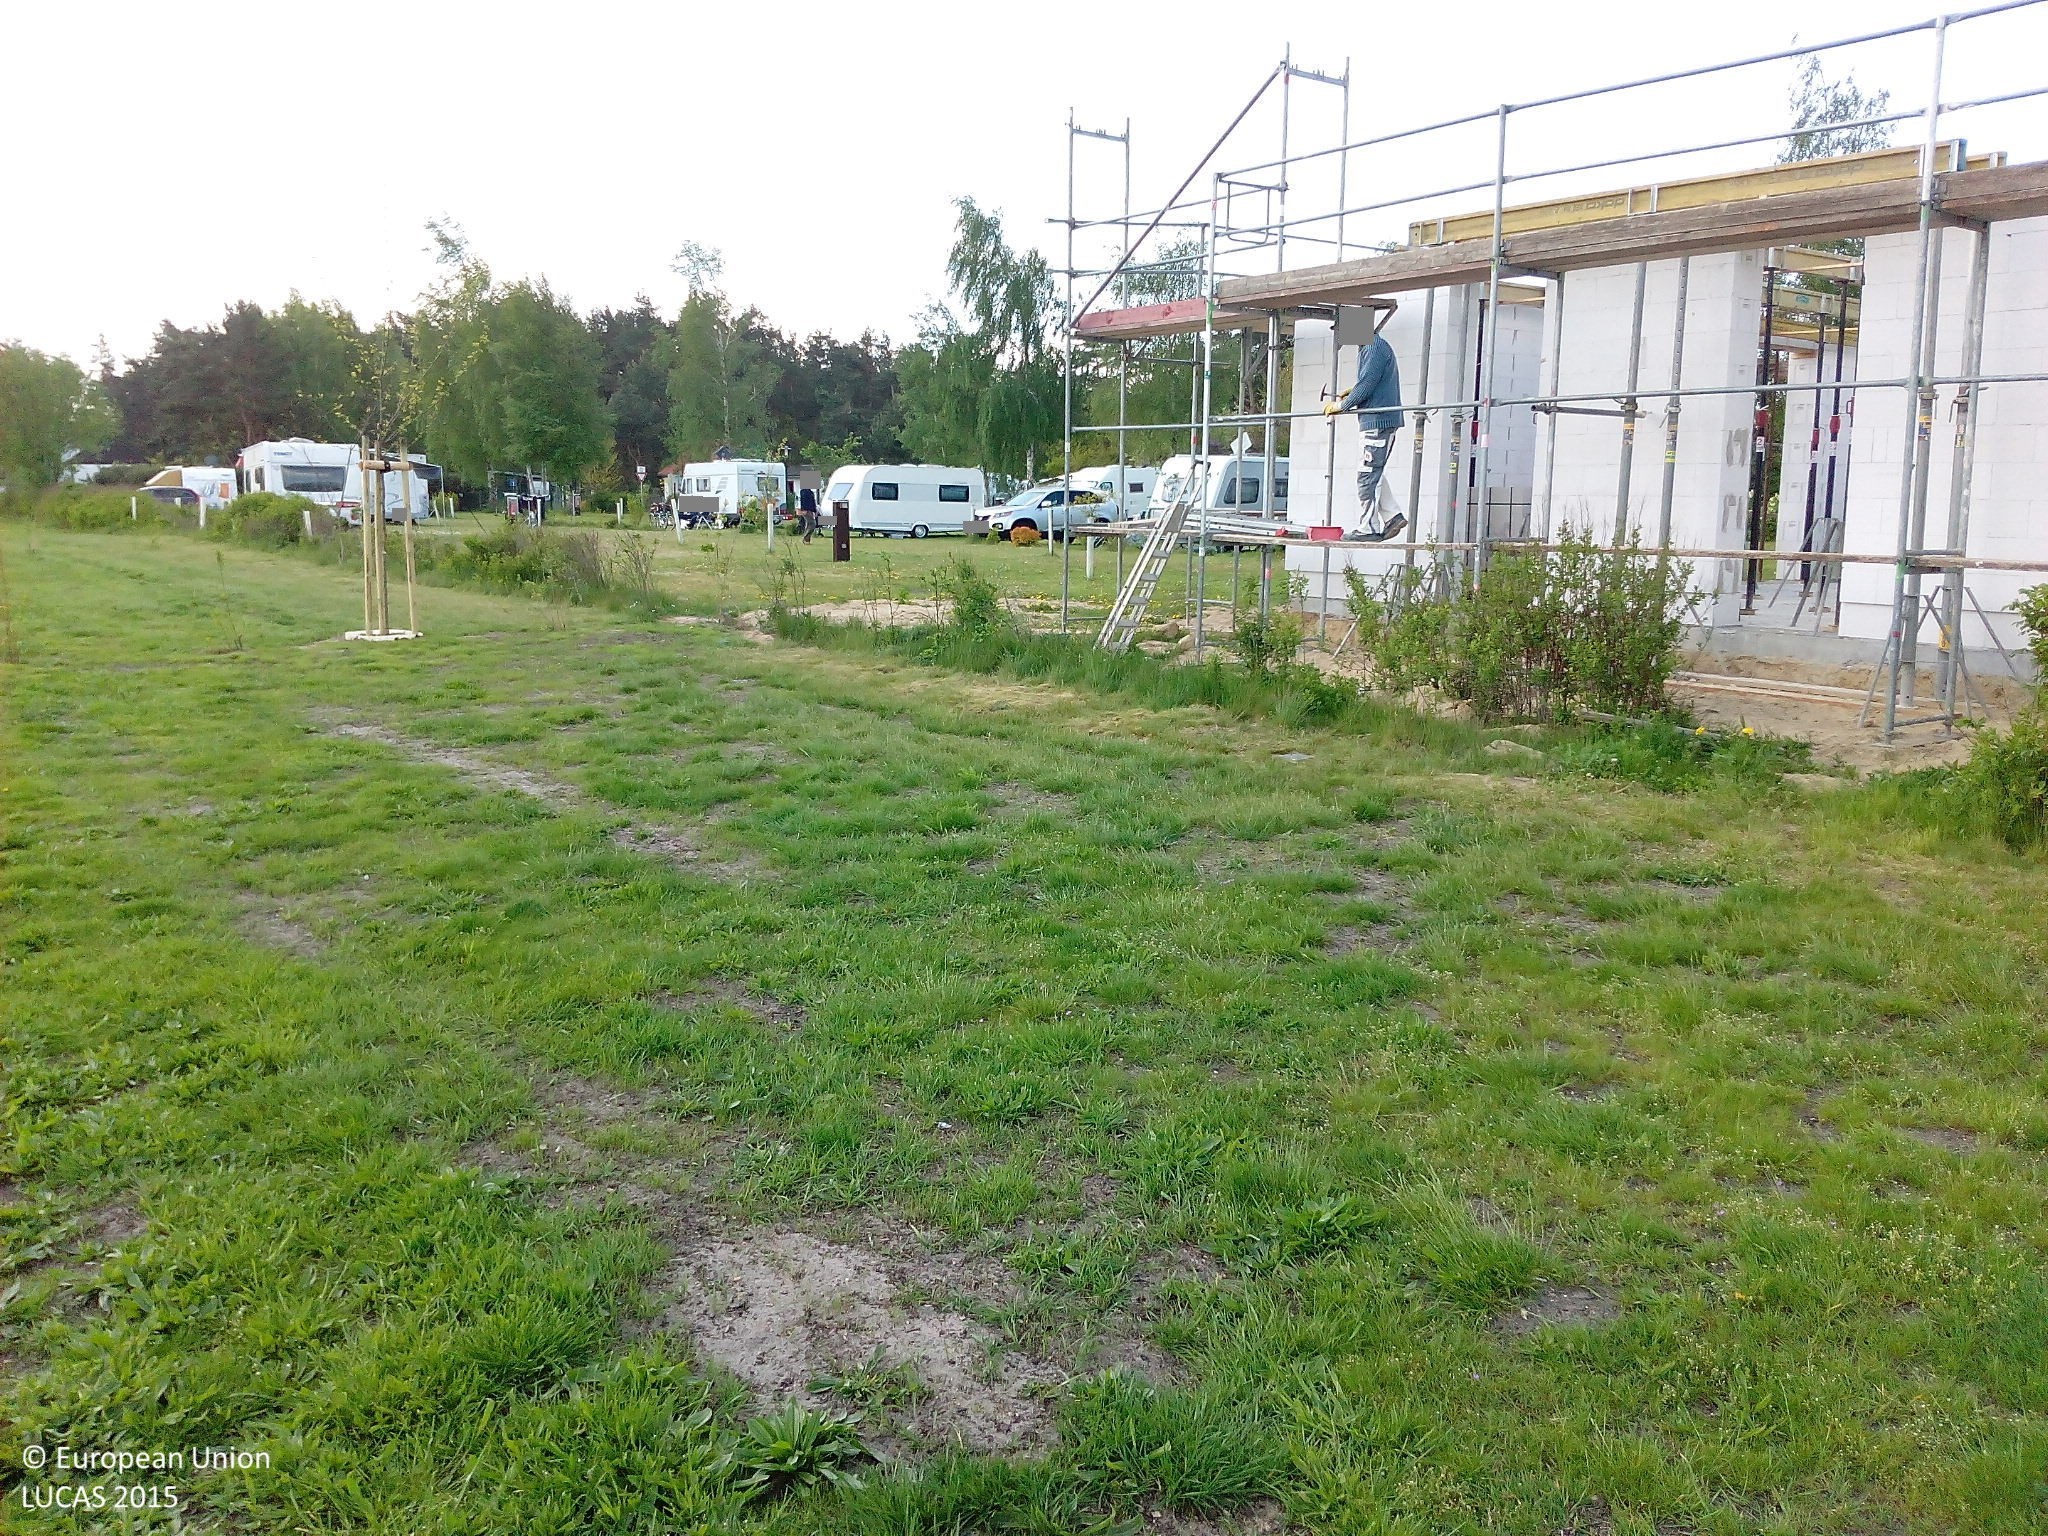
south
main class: Grassland
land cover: Grassland with sparse tree/shrub cover
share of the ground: > 75 %
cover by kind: herbaceous plants 85 %, broadleaved forest trees 5 %, shrubs 5 %, unconsolidated bare surface 5 %
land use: Amenities, museums, leisure
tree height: < 5 m
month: May
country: DE
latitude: 54.3797
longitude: 12.6625
